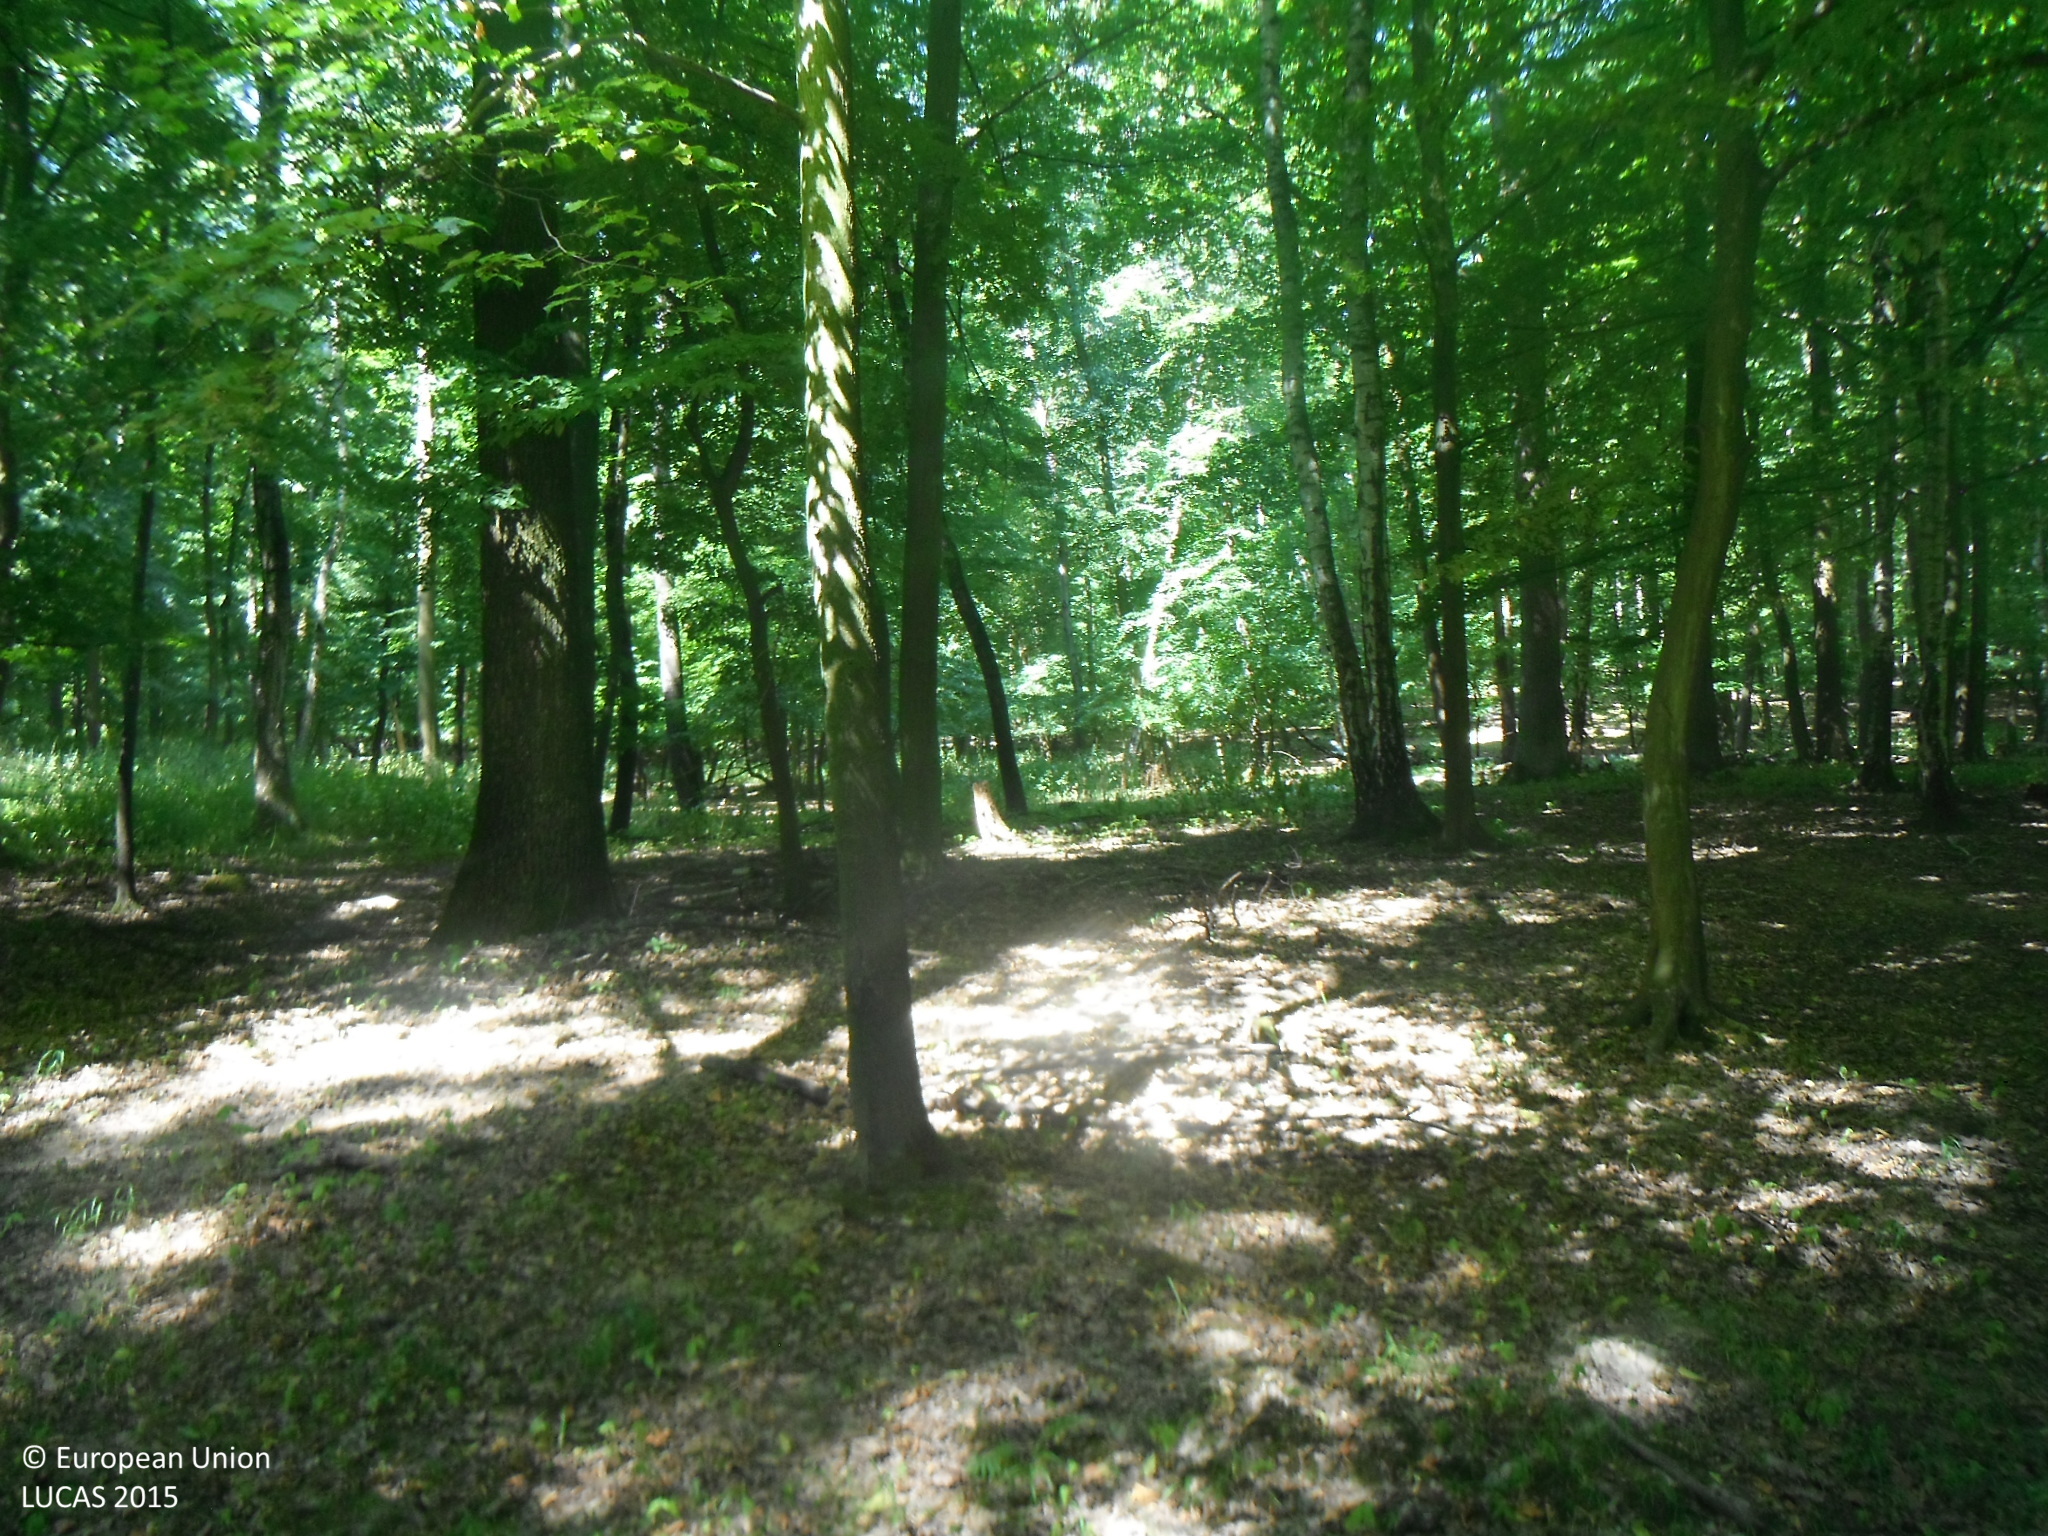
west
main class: Woodland
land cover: Broadleaved woodland
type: mesophytic deciduous forest
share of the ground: > 75 %
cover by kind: broadleaved forest trees 95 %, herbaceous plants 5 %
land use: Forestry
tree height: > 5 m
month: July
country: SK
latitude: 48.7250
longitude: 17.2554
